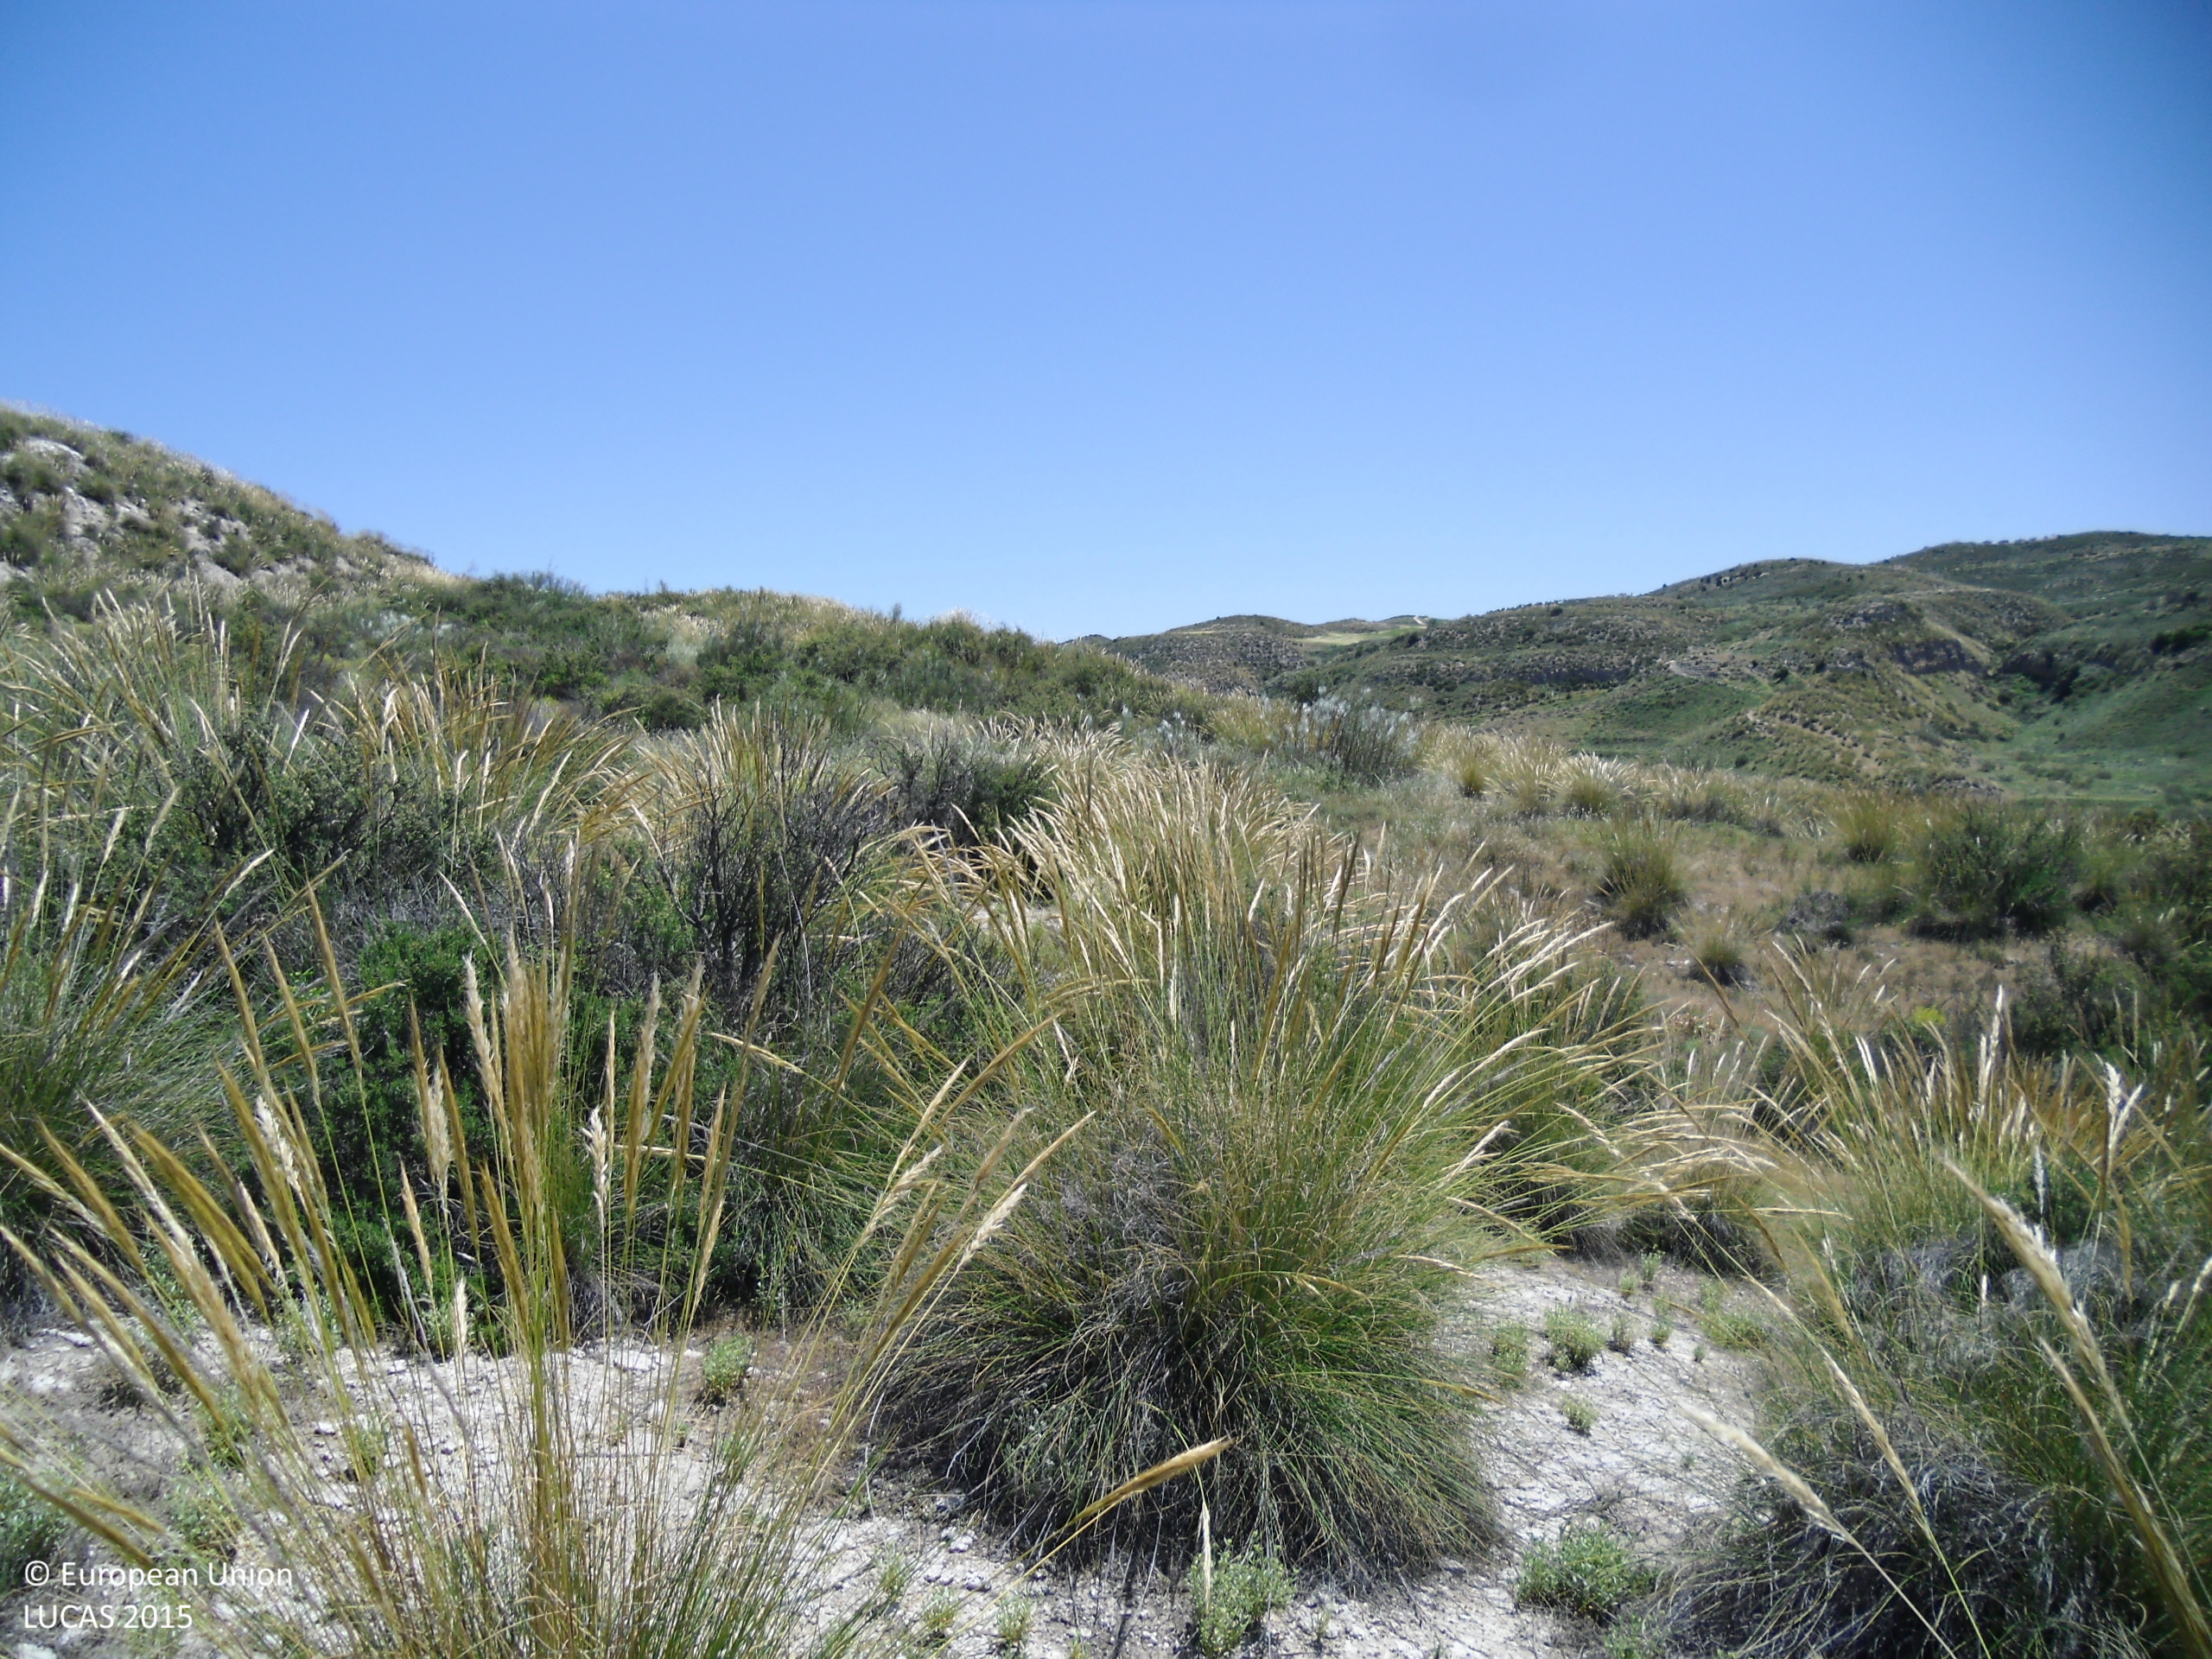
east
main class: Shrubland
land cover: Shrubland without tree cover
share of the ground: > 75 %
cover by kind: shrubs 80 %, herbaceous plants 10 %, consolidated bare surface 10 %
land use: Semi-natural and natural areas not in use
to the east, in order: Shrubland without tree cover; Dry stone walls; Shrubland without tree cover; Rivers and streams; Shrubland with sparse tree cover
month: May
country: ES
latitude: 40.2295
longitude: -2.9420
